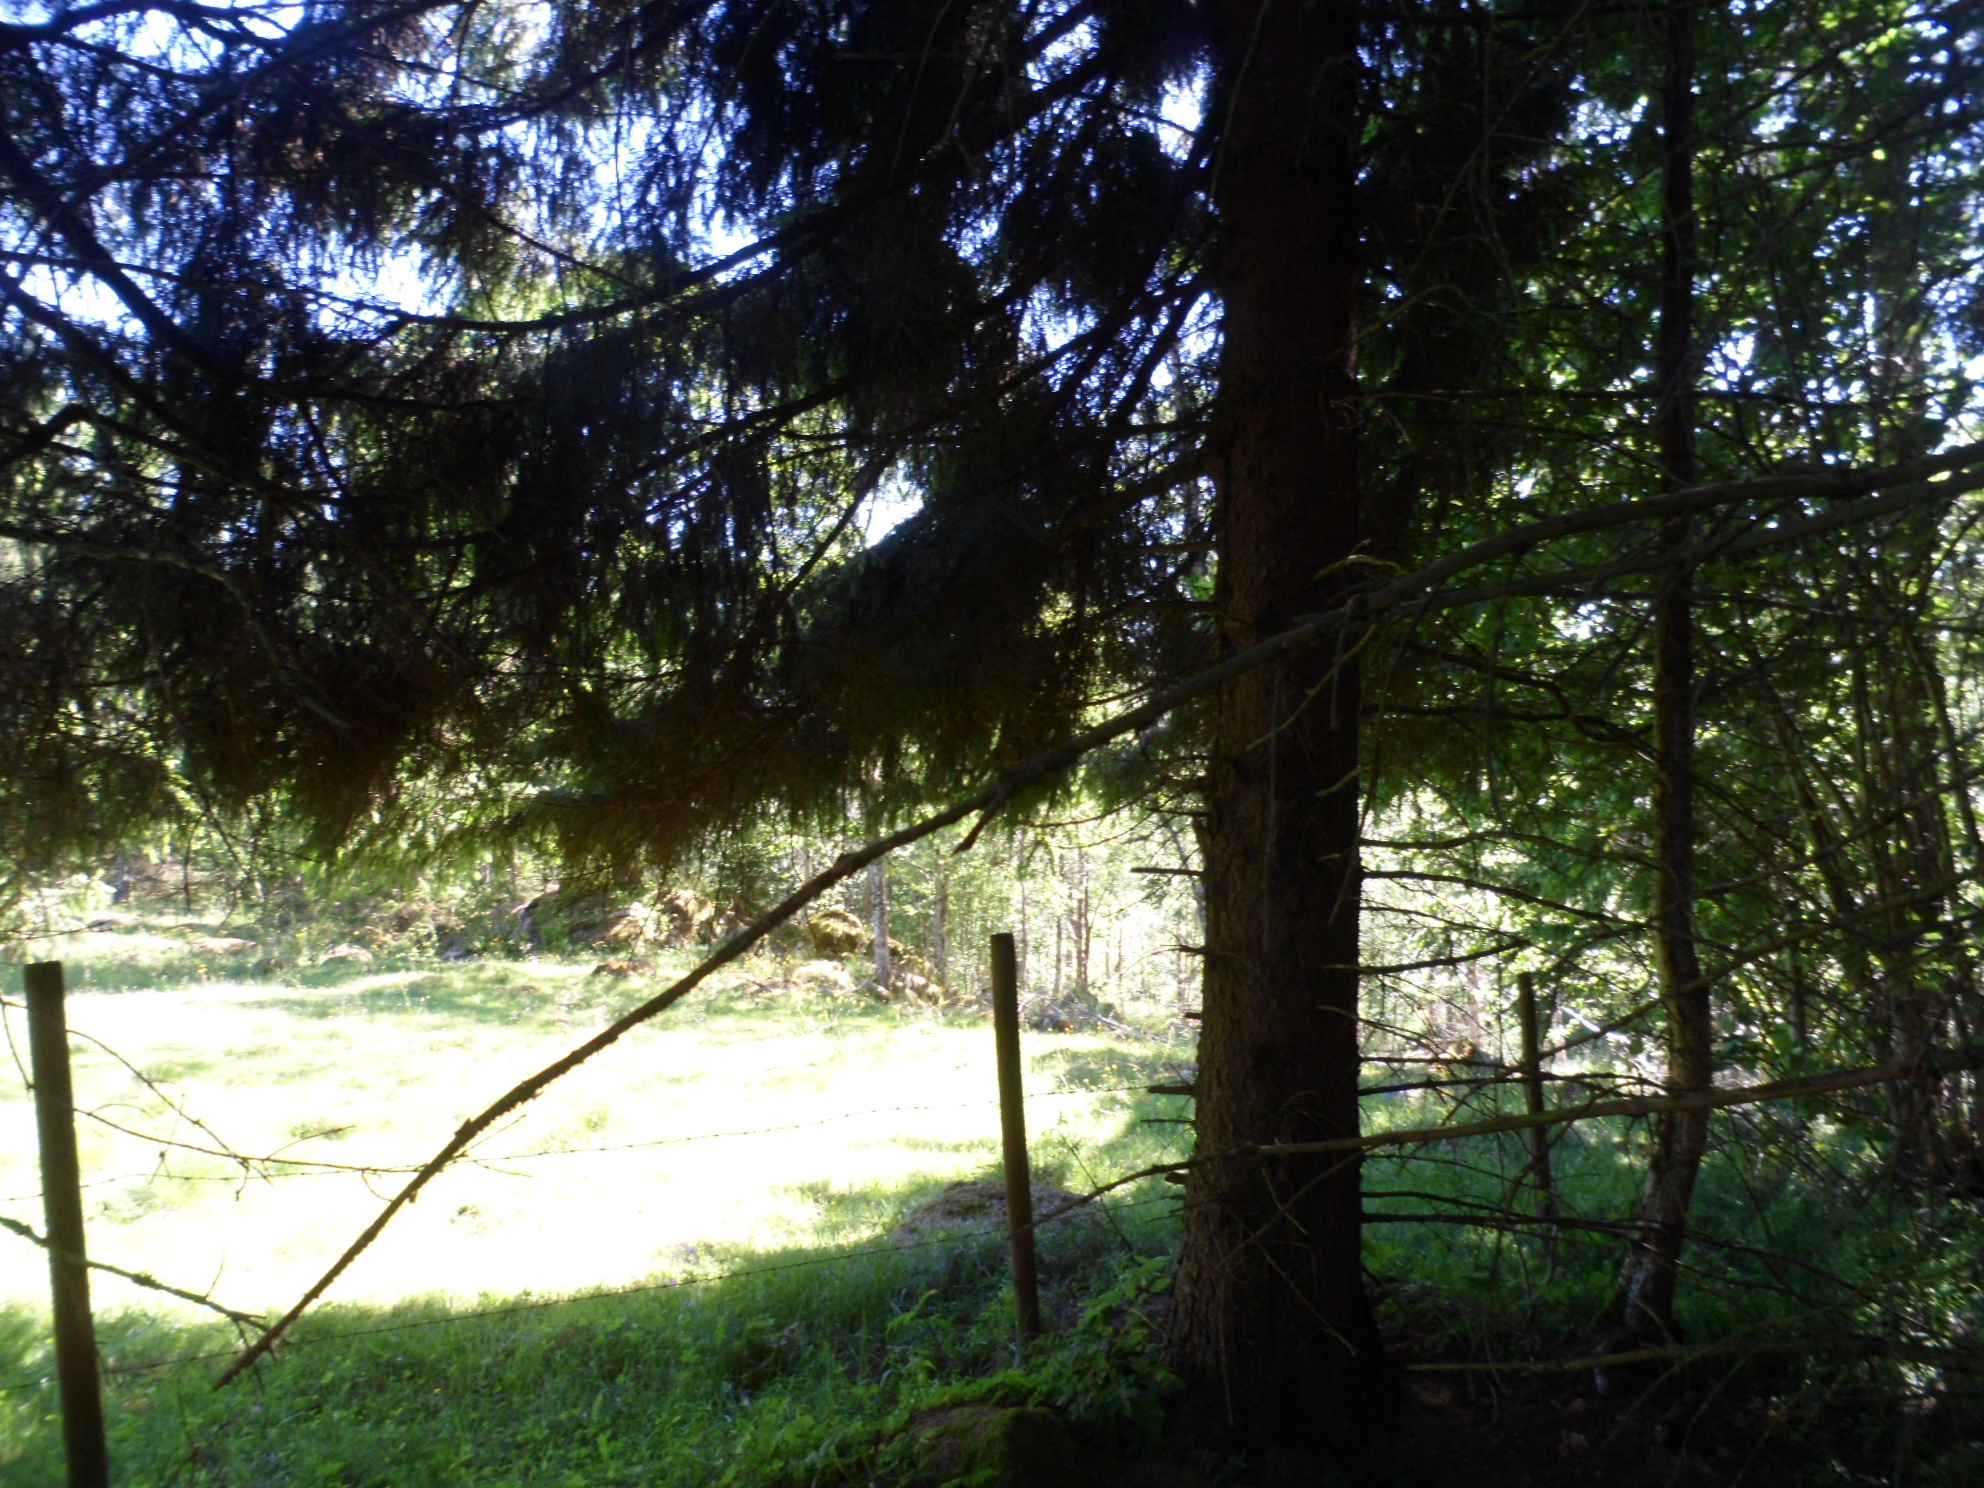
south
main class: Woodland
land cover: Spruce dominated coniferous woodland
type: boreal forest
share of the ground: > 75 %
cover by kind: coniferous forest trees 75 %, herbaceous plants 10 %, broadleaved forest trees 5 %, shrubs 5 %, lichens and mosses 5 %
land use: Forestry
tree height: > 5 m
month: July
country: SE
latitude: 57.5108
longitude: 14.5860
